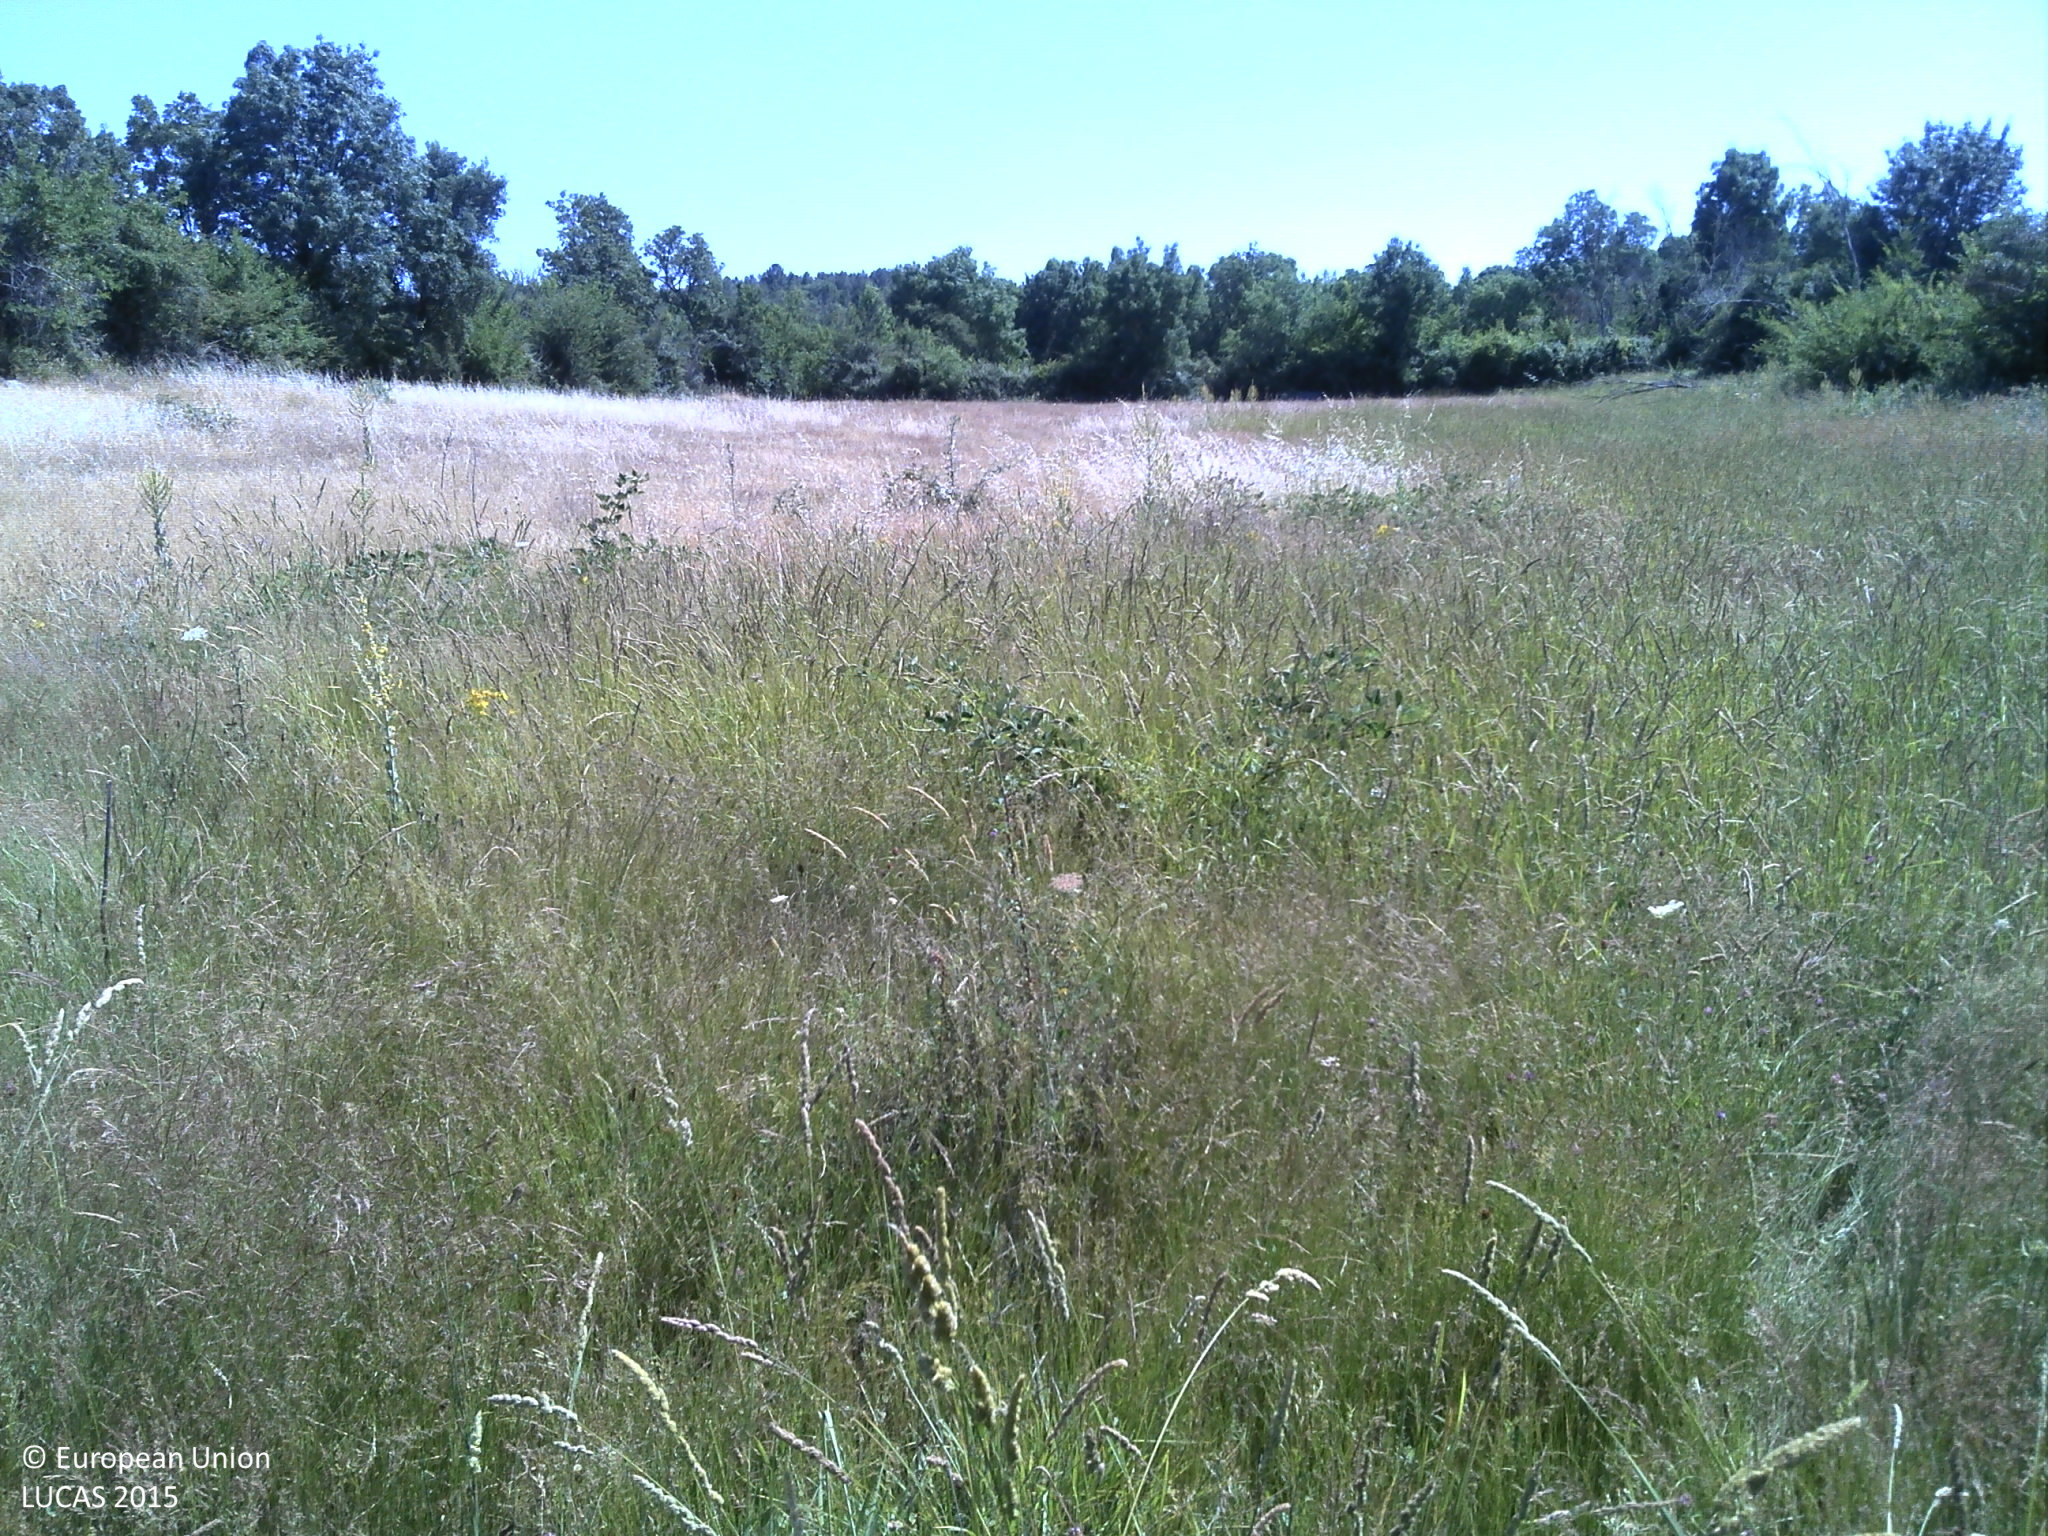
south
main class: Grassland
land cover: Grassland without tree/shrub cover
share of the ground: > 75 %
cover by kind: herbaceous plants 100 %
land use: Agriculture (excluding fallow land and kitchen gardens)
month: June
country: PT
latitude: 40.8691
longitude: -6.9156
